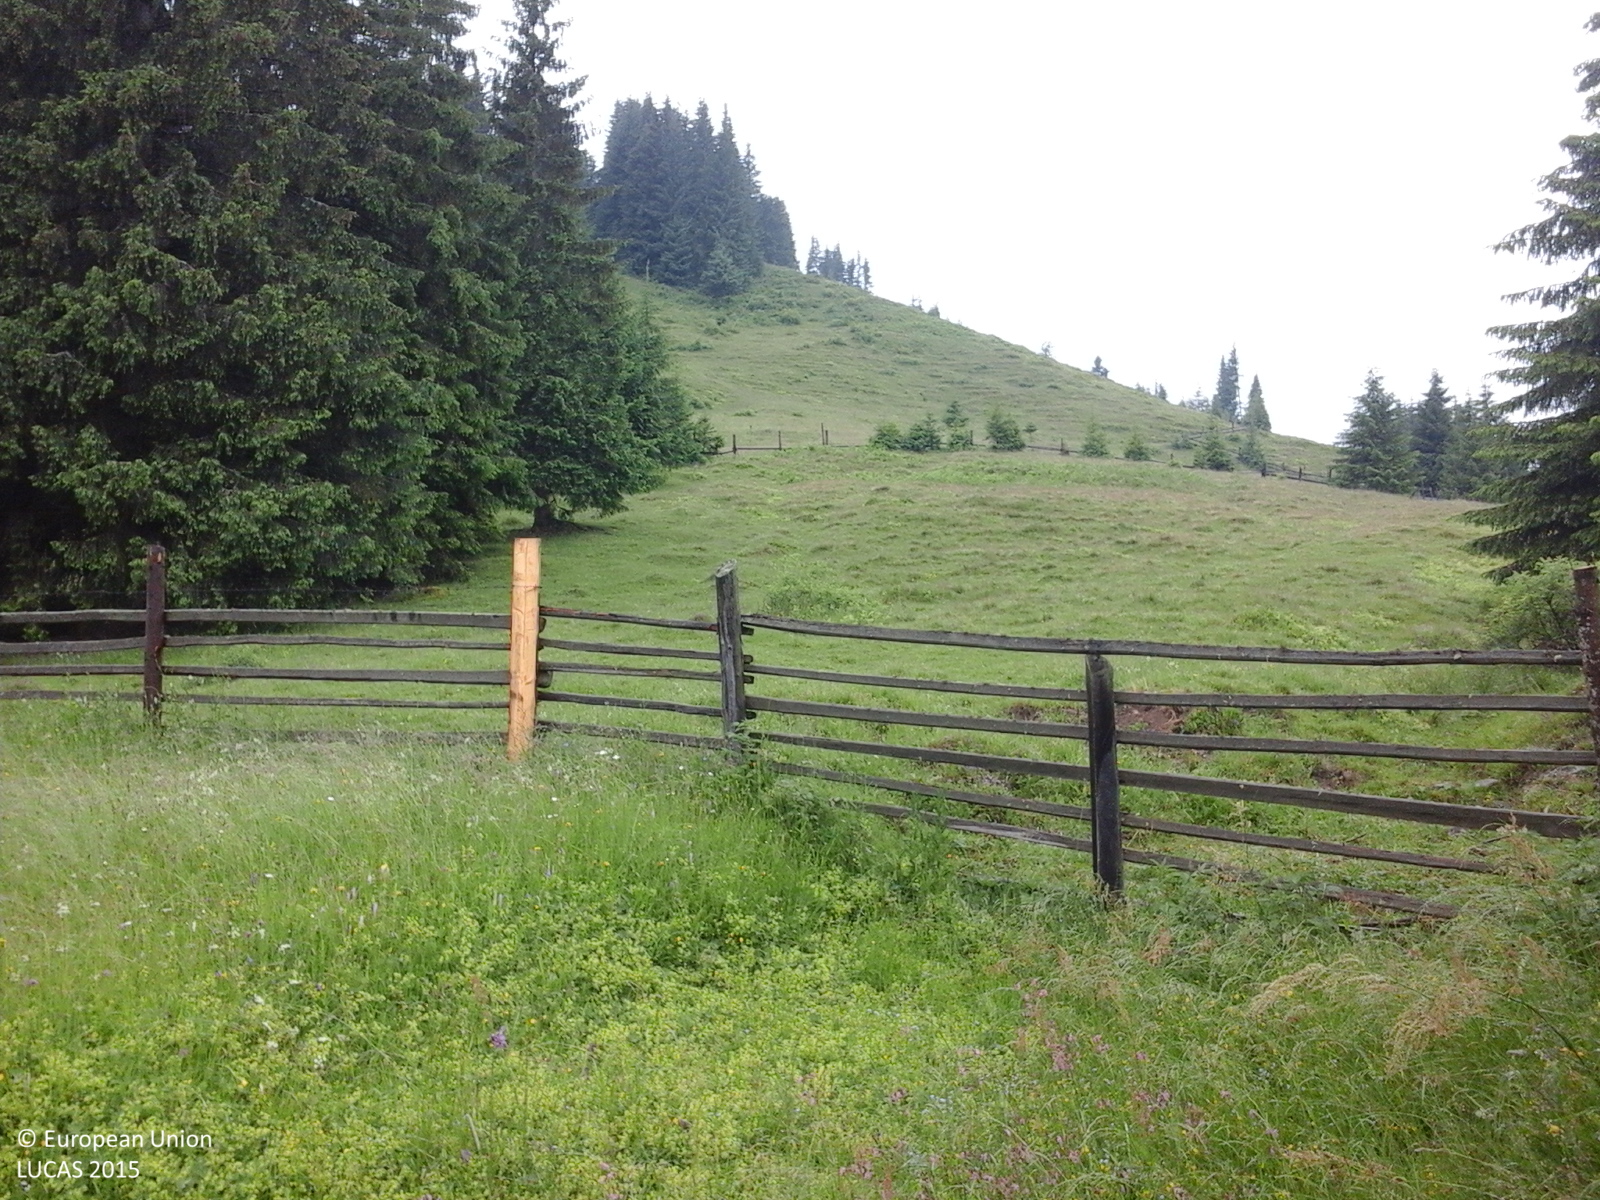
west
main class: Grassland
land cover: Grassland without tree/shrub cover
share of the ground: > 75 %
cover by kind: herbaceous plants 100 %
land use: Agriculture (excluding fallow land and kitchen gardens)
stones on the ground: < 10 %
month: June
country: RO
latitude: 47.2230
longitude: 25.2828
